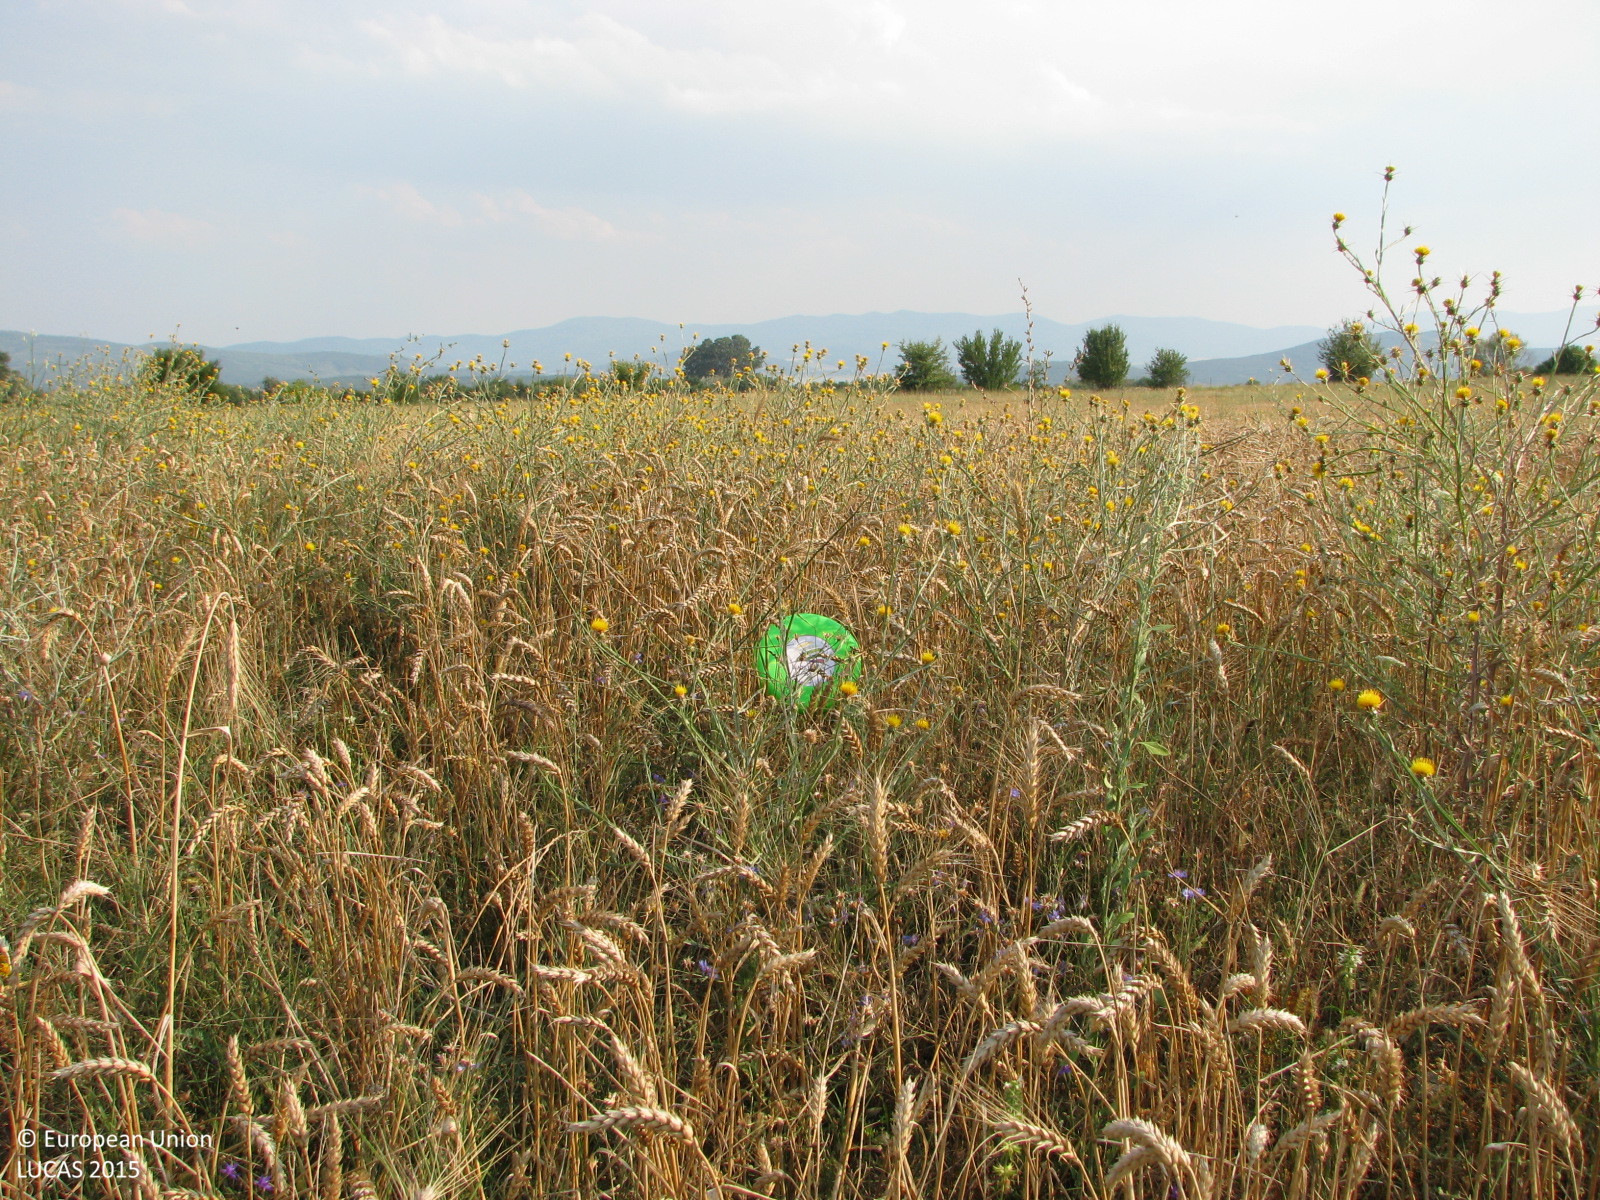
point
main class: Cropland
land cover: Common wheat
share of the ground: > 75 %
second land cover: Spontaneously vegetated surfaces
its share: 10 - 25 %
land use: Agriculture (excluding fallow land and kitchen gardens)
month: July
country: BG
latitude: 42.6809
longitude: 25.8594
